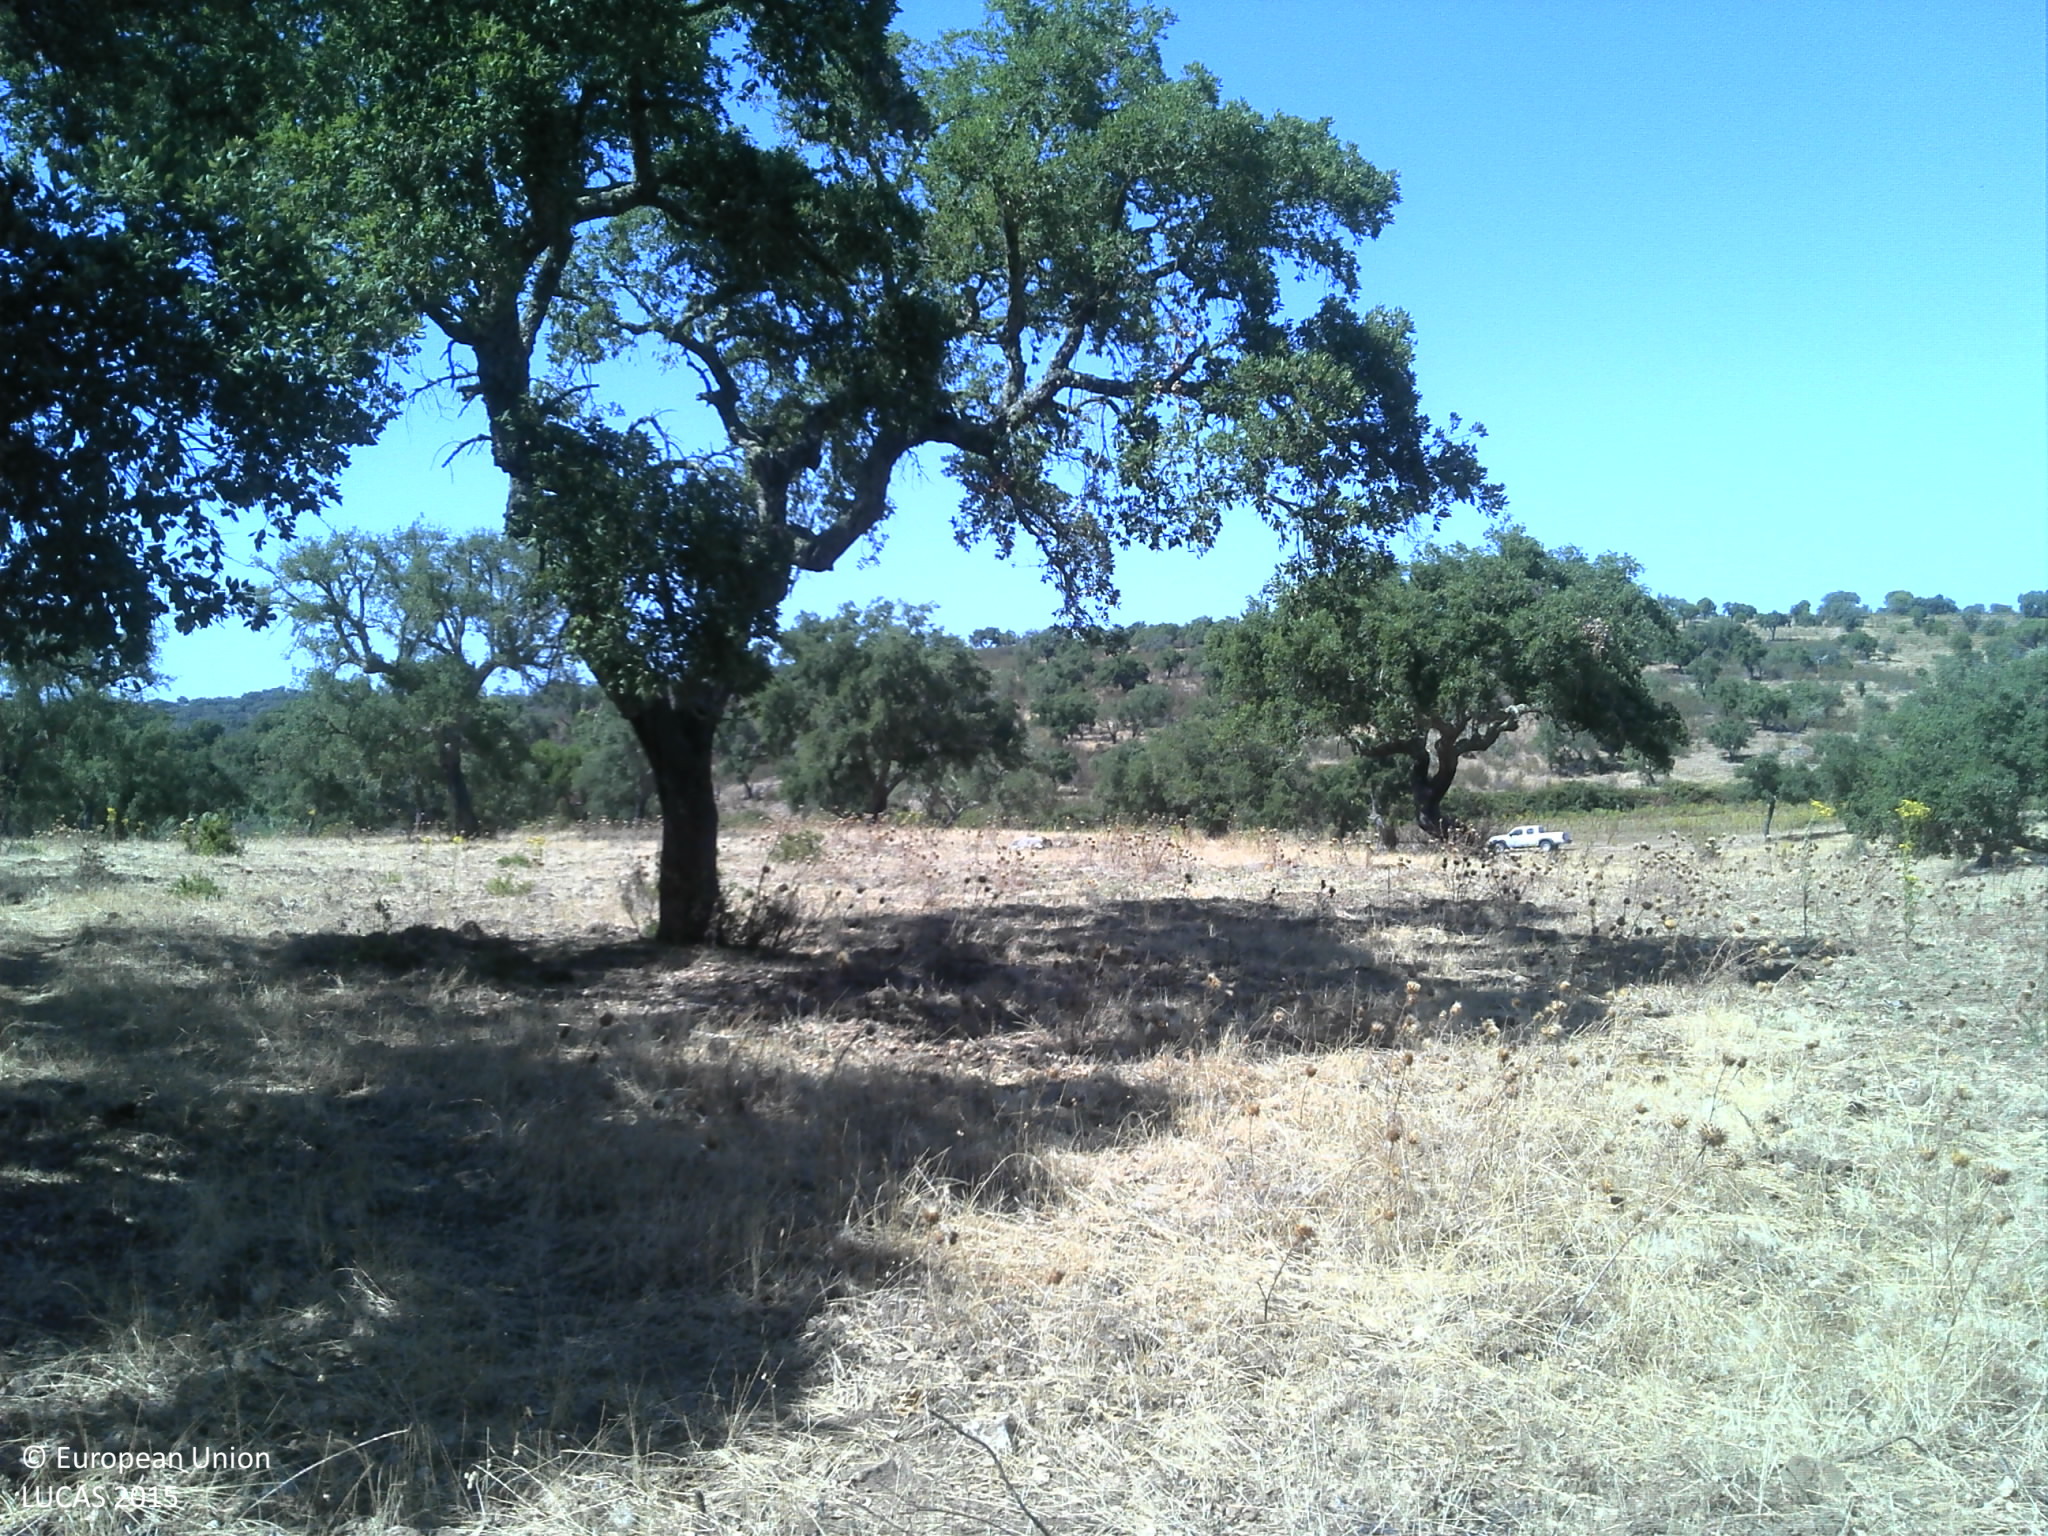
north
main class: Woodland
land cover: Broadleaved woodland
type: broadleaved evergreen forest
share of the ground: 25 - 50 %
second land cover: Grassland without tree/shrub cover
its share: 25 - 50 %
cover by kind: broadleaved forest trees 40 %, unconsolidated bare surface 35 %, herbaceous plants 25 %
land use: Forestry
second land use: Agriculture (excluding fallow land and kitchen gardens)
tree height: > 5 m
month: July
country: PT
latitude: 38.9939
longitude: -8.1930
